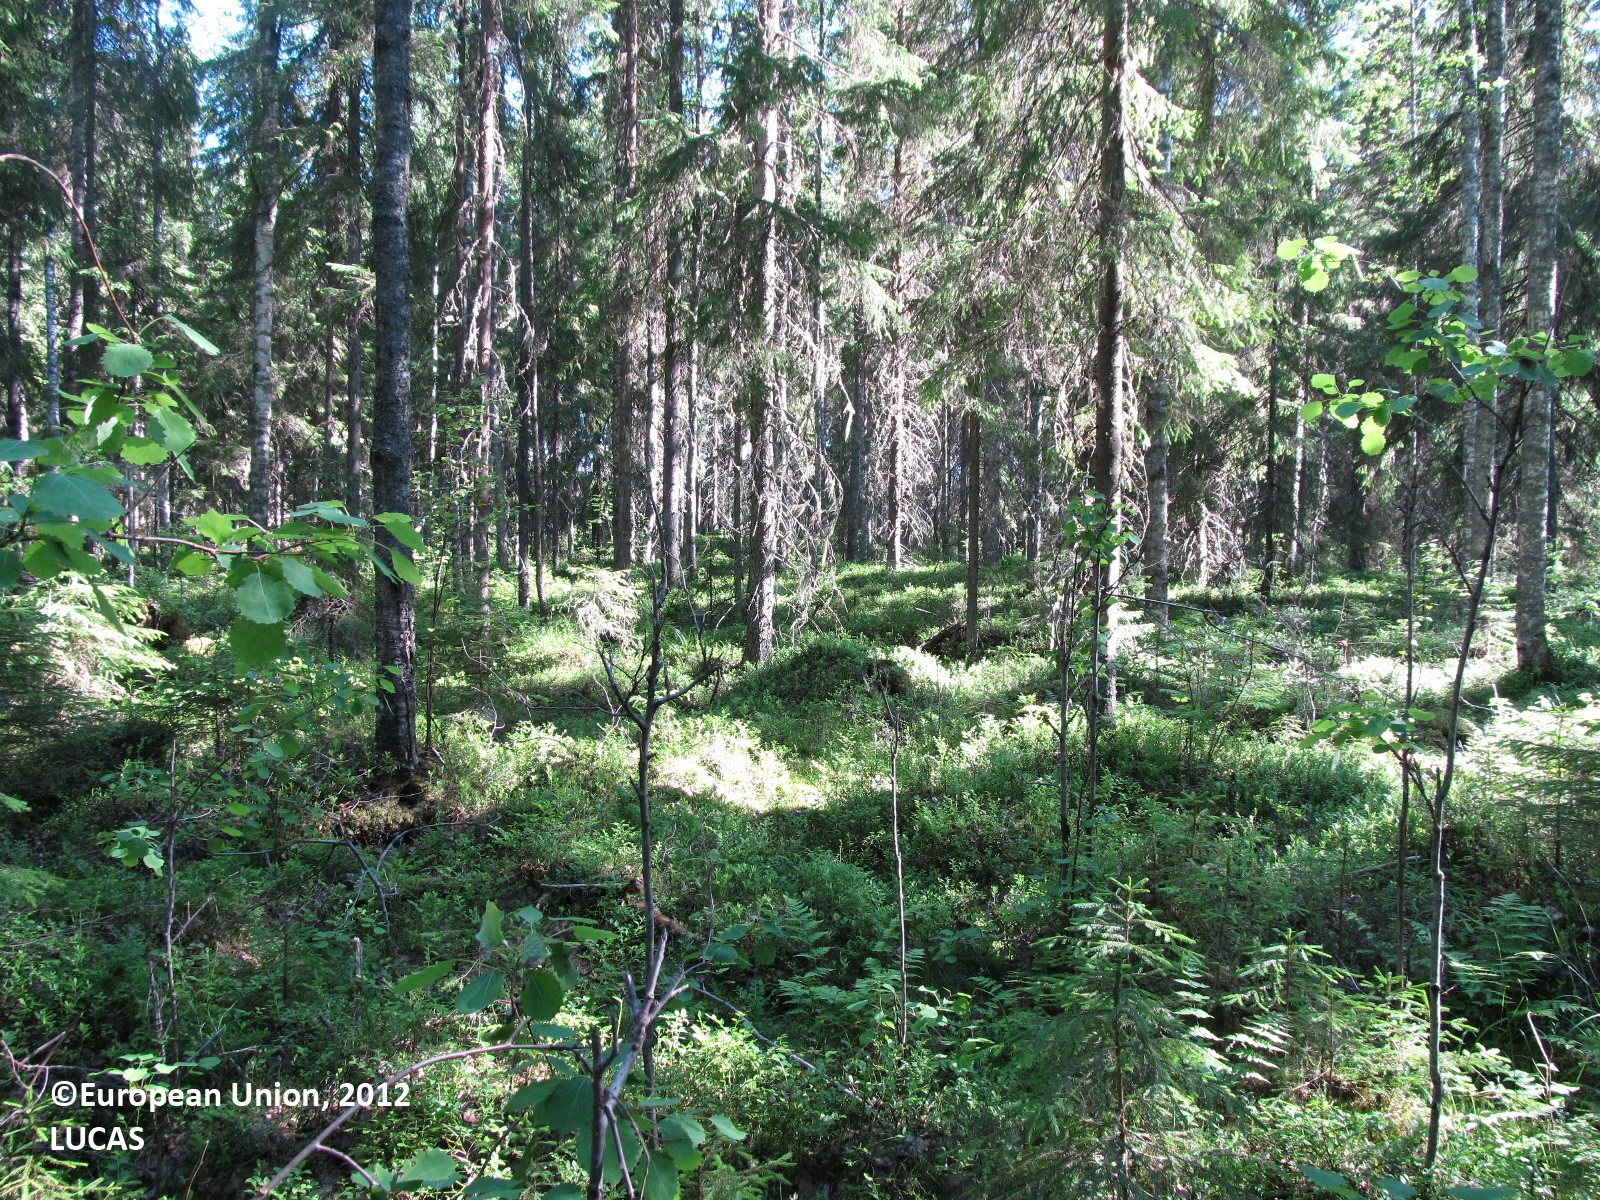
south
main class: Woodland
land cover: Spruce dominated coniferous woodland
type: boreal forest
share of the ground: 50 - 75 %
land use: Forestry
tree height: > 5 m
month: July
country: FI
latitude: 62.5603
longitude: 28.9897
